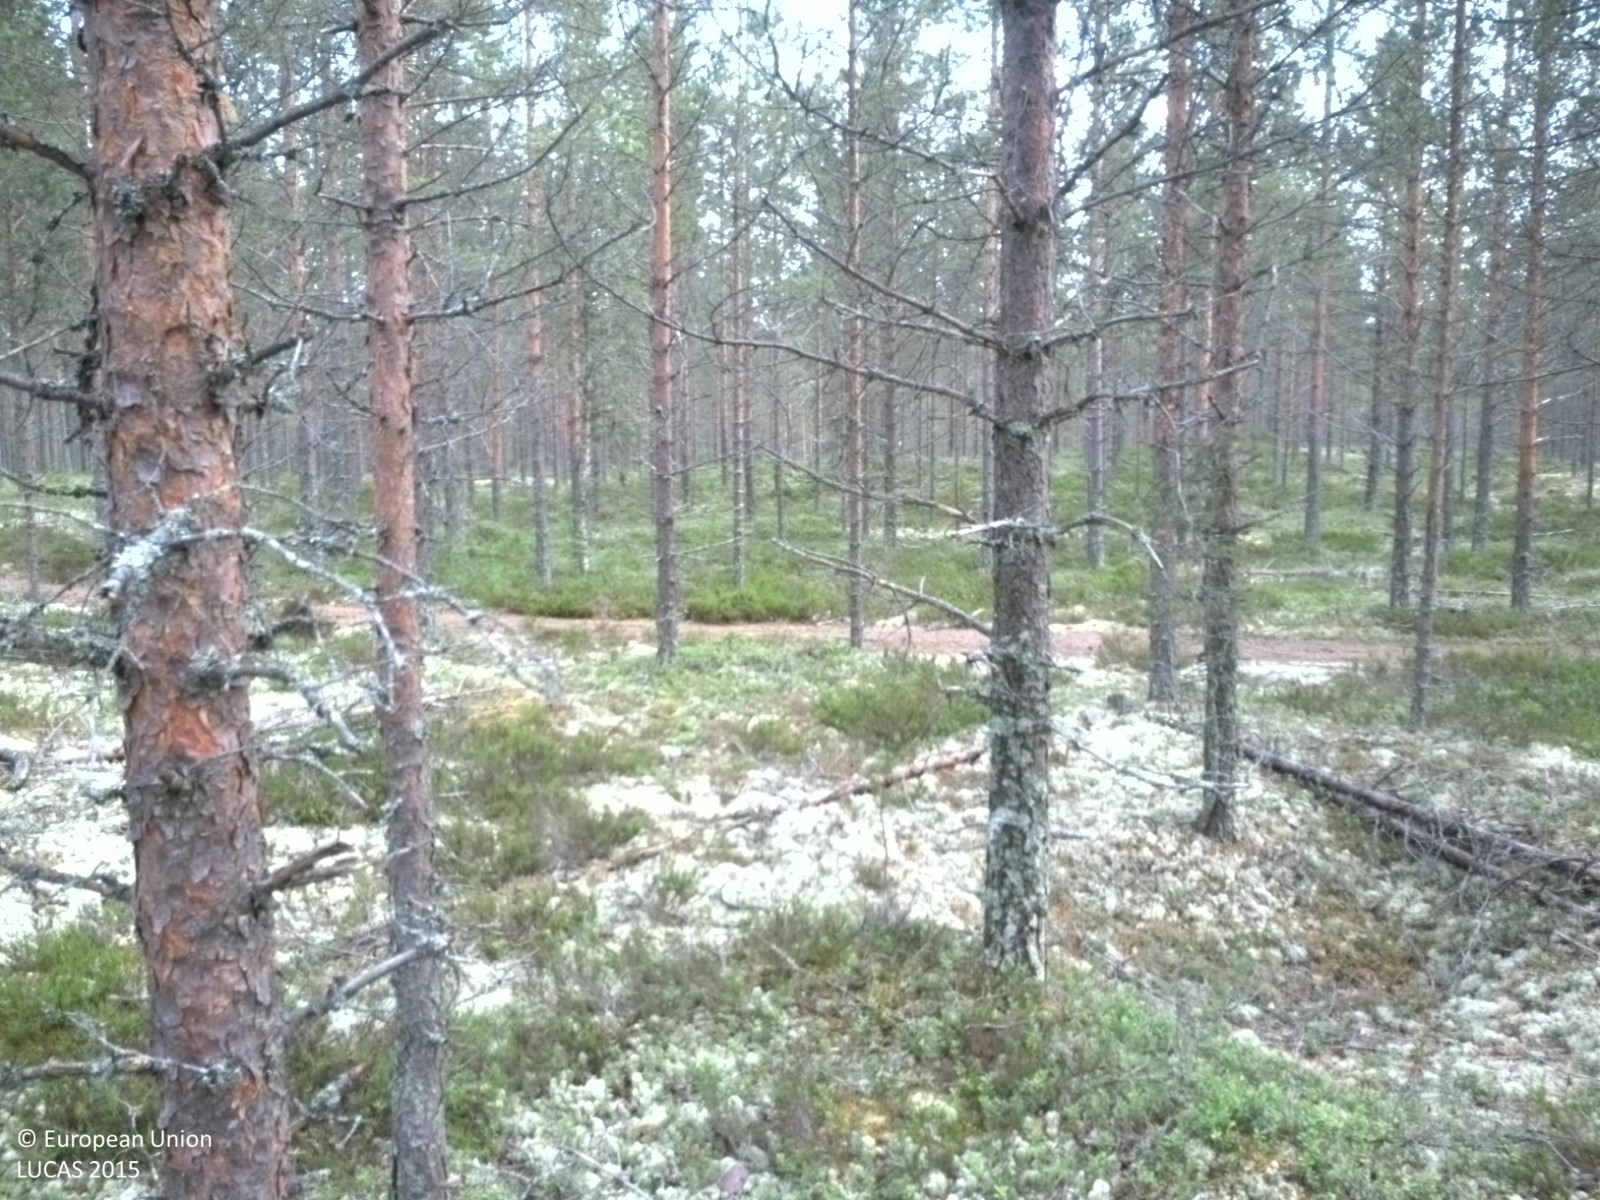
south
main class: Woodland
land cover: Pine dominated coniferous woodland
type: boreal forest
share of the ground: 25 - 50 %
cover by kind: lichens and mosses 75 %, coniferous forest trees 25 %
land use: Forestry
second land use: Amenities, museums, leisure
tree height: > 5 m
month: July
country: SE
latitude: 63.5893
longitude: 19.4297
